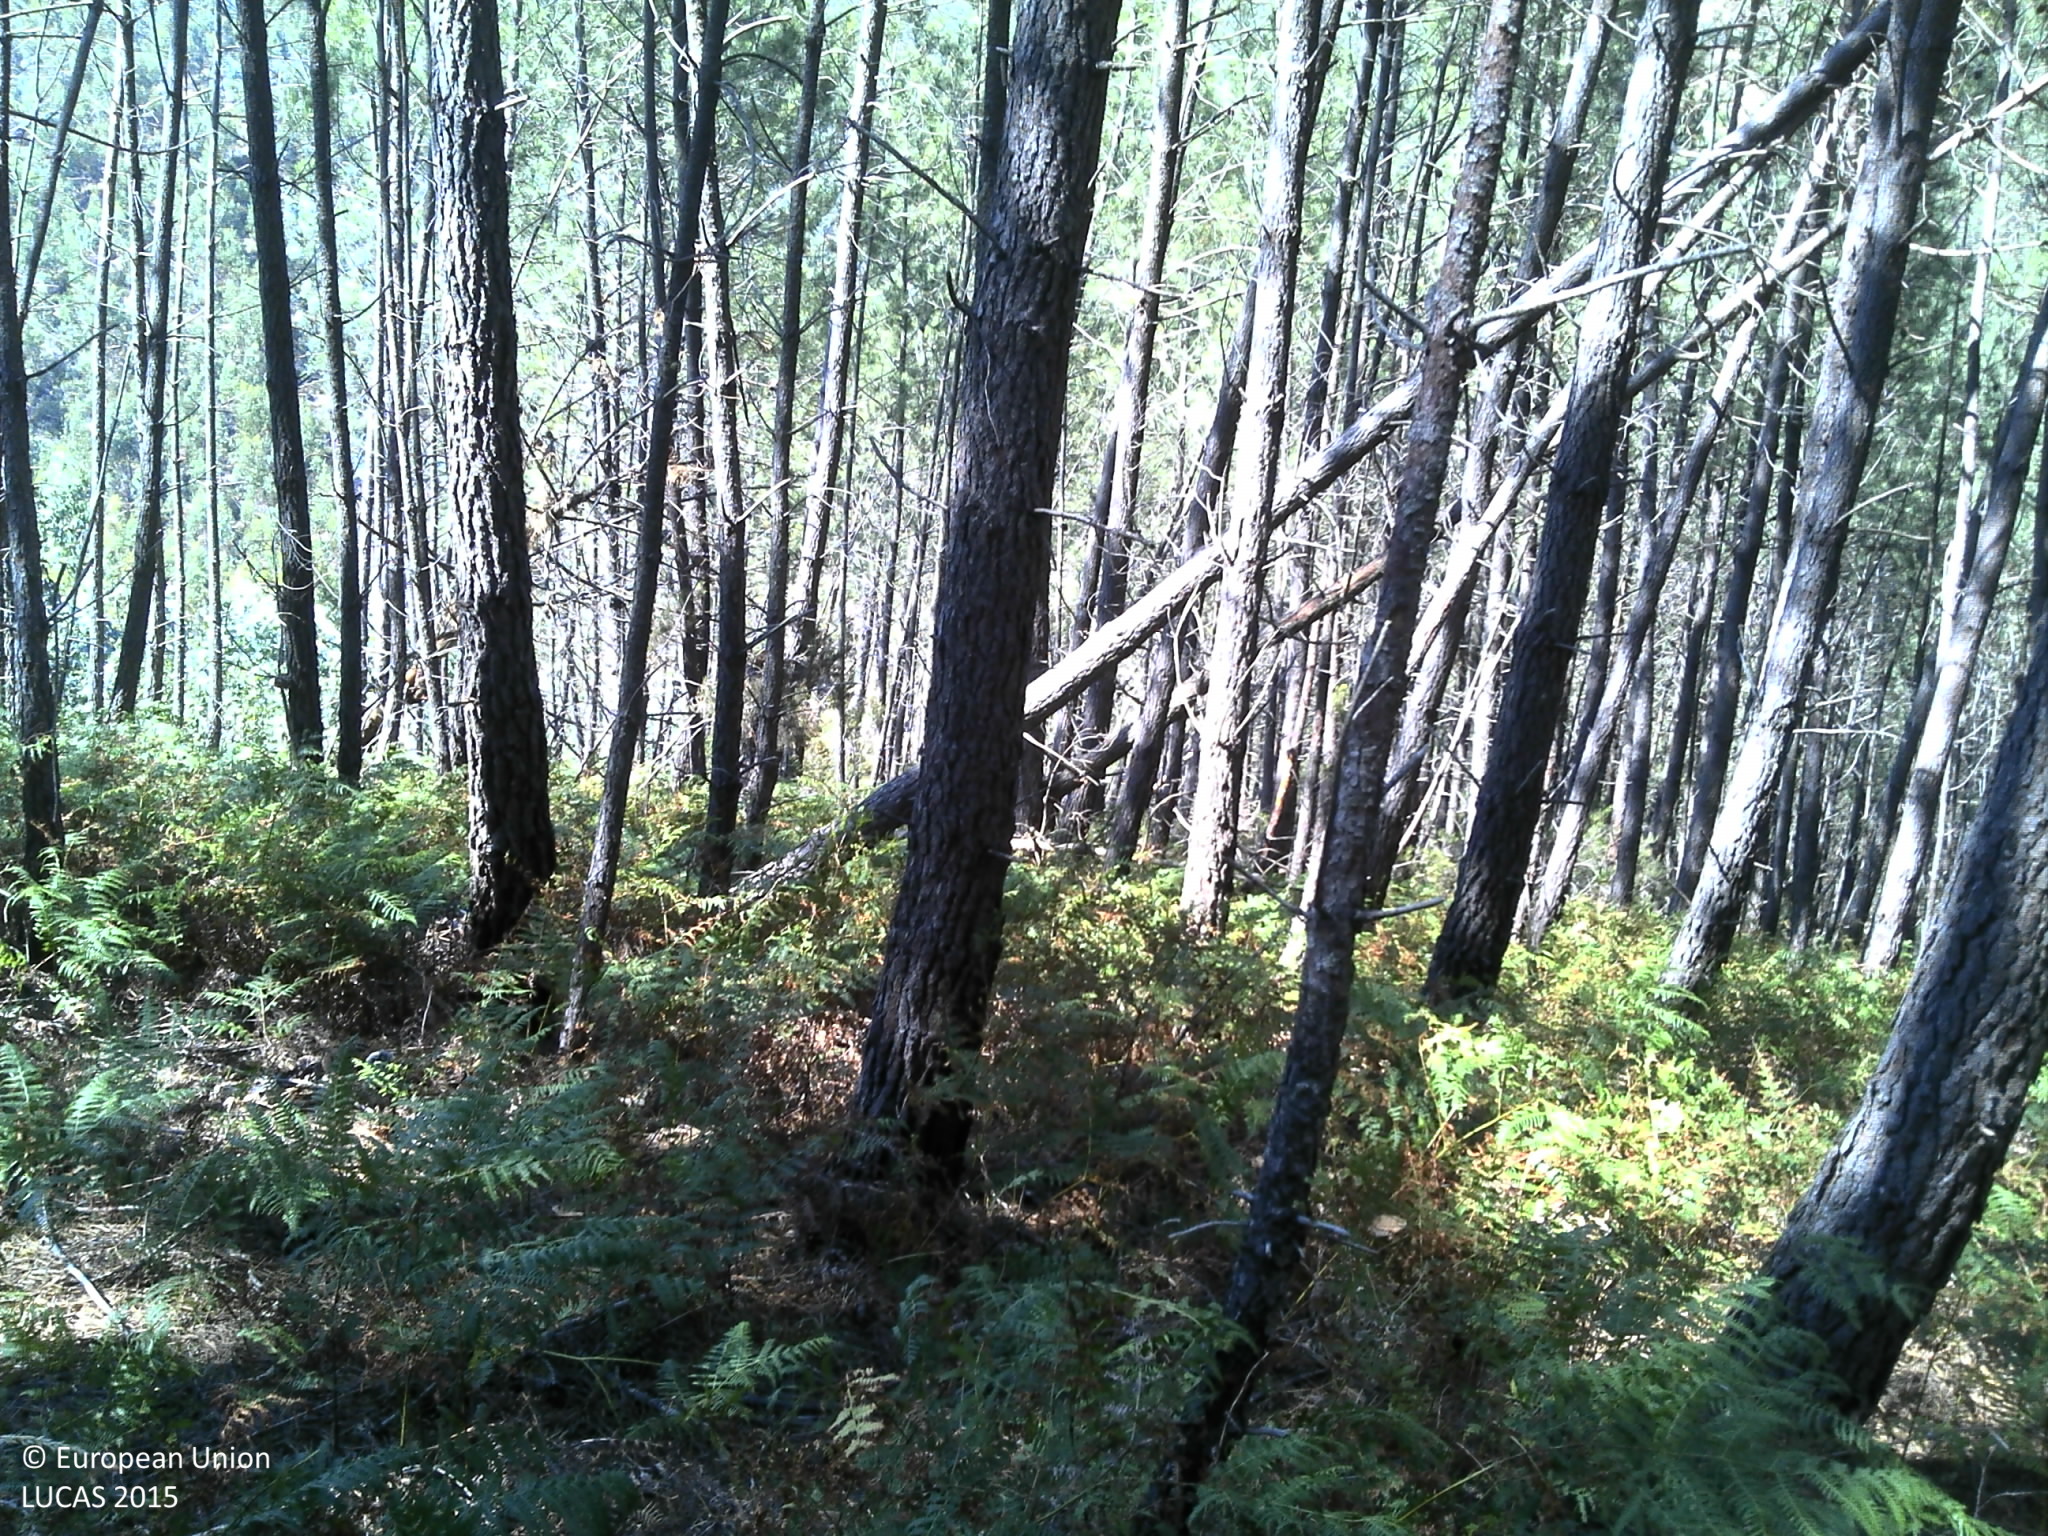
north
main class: Woodland
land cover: Pine dominated coniferous woodland
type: coniferous forest of the mediterranean region
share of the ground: 25 - 50 %
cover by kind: coniferous forest trees 45 %, unconsolidated bare surface 45 %, herbaceous plants 10 %
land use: Forestry
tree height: > 5 m
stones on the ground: < 10 %
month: June
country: PT
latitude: 40.0840
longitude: -8.0977
